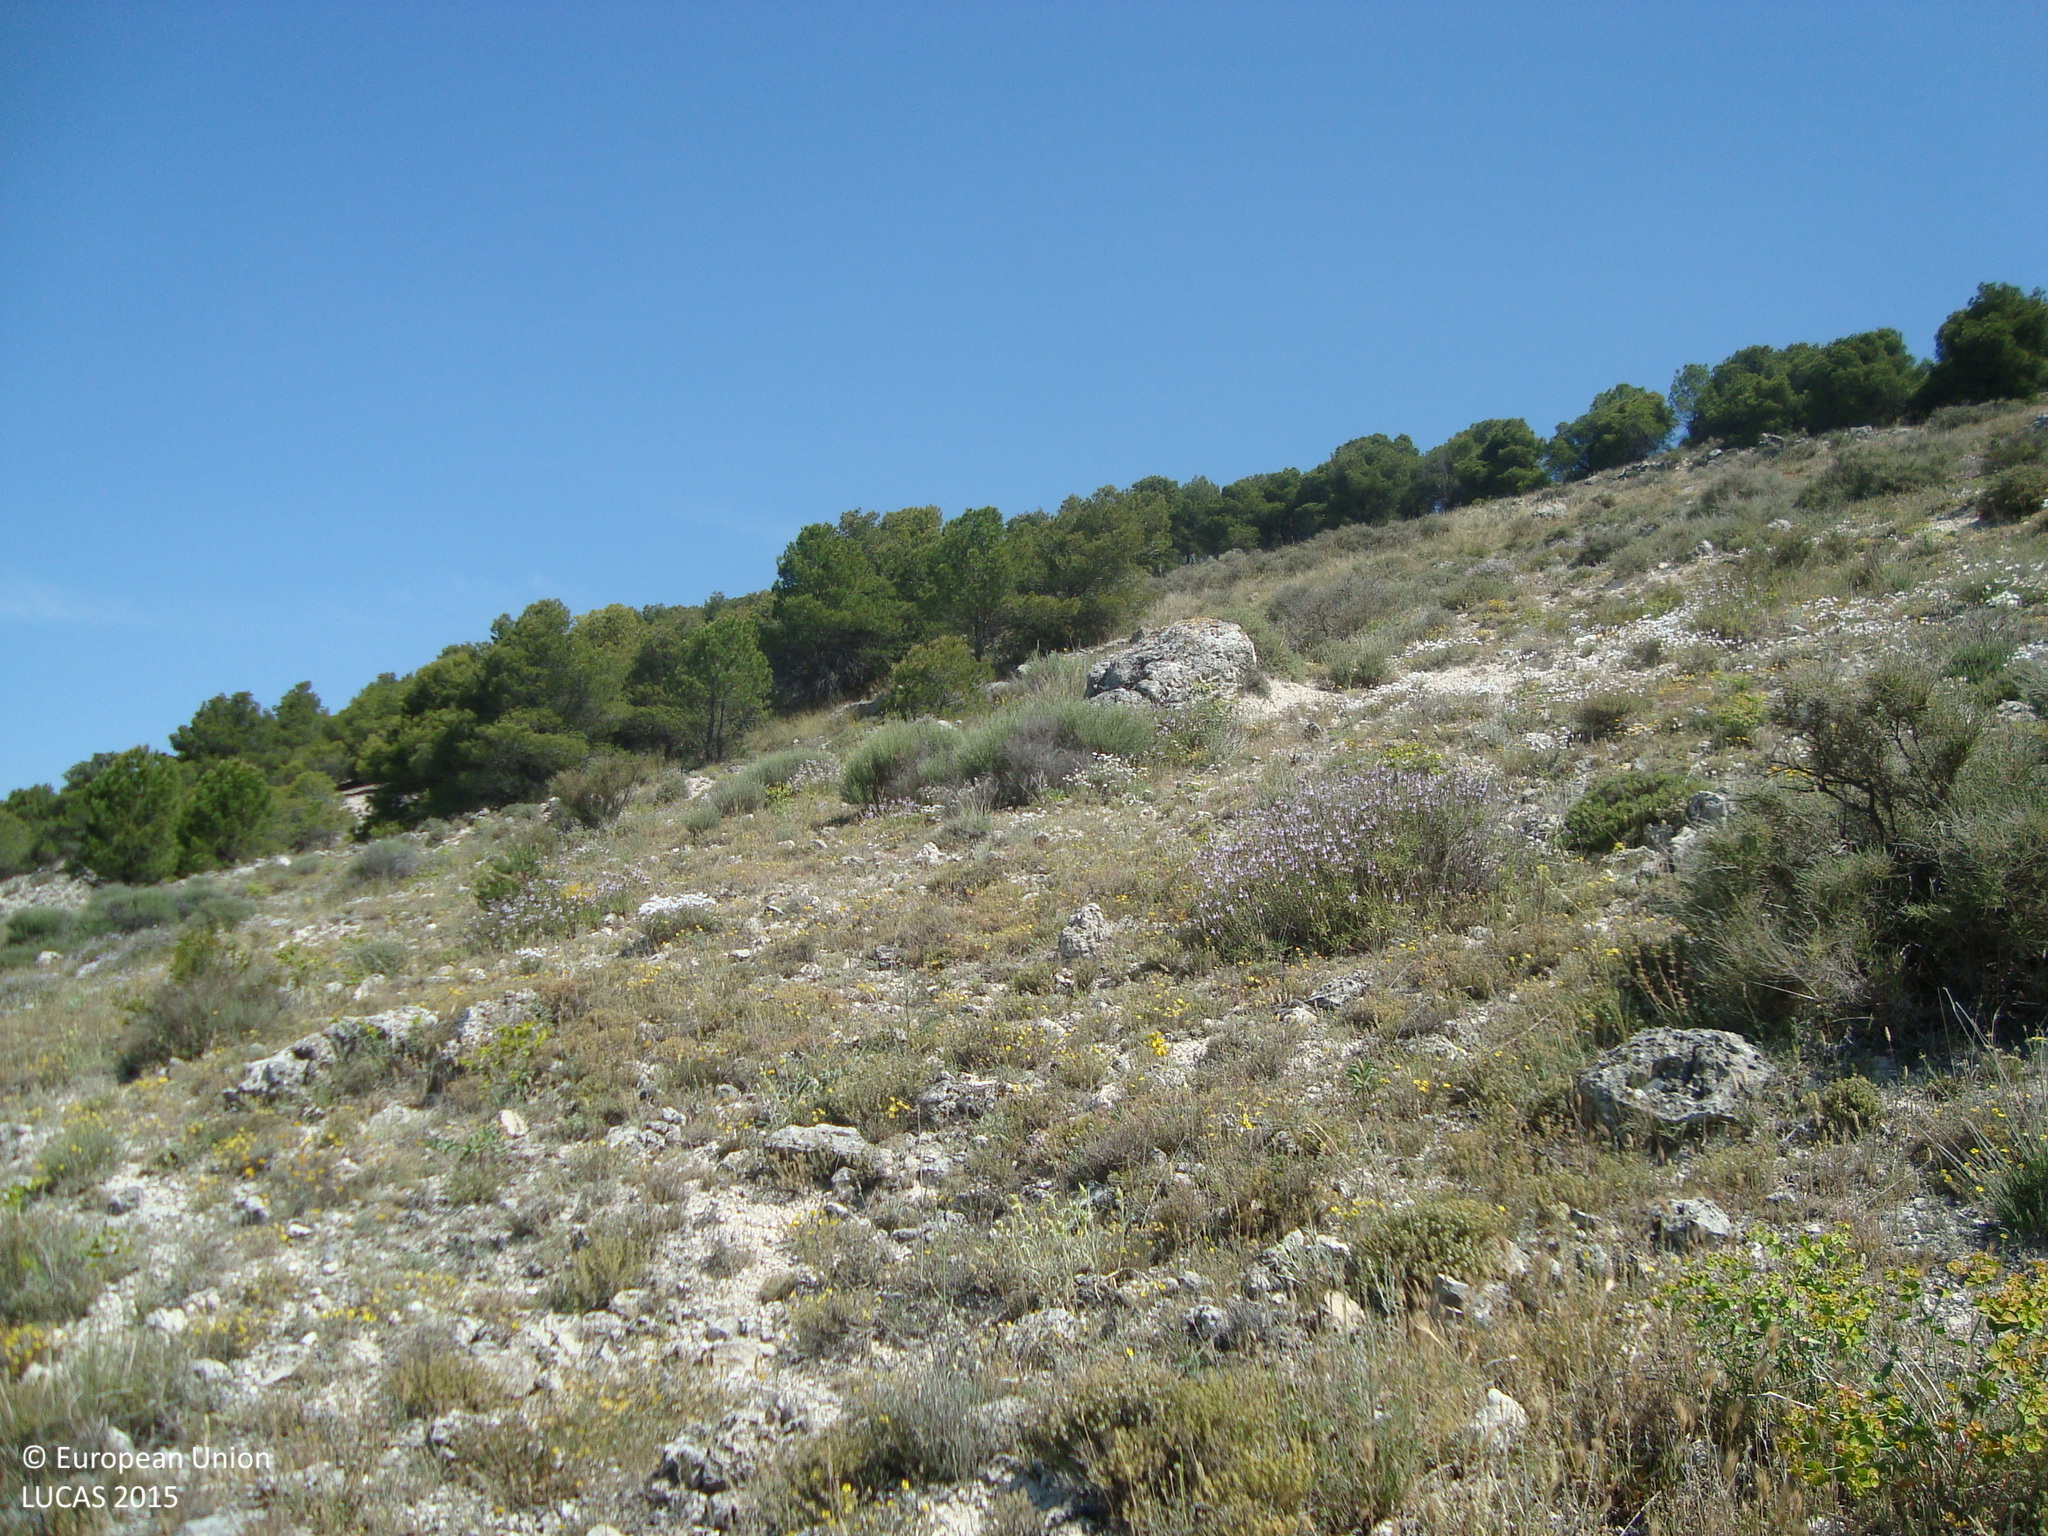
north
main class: Shrubland
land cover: Shrubland without tree cover
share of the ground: 50 - 75 %
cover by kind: shrubs 70 %, unconsolidated bare surface 20 %, herbaceous plants 10 %
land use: Semi-natural and natural areas not in use
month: May
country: ES
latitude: 41.5915
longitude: -4.0815
